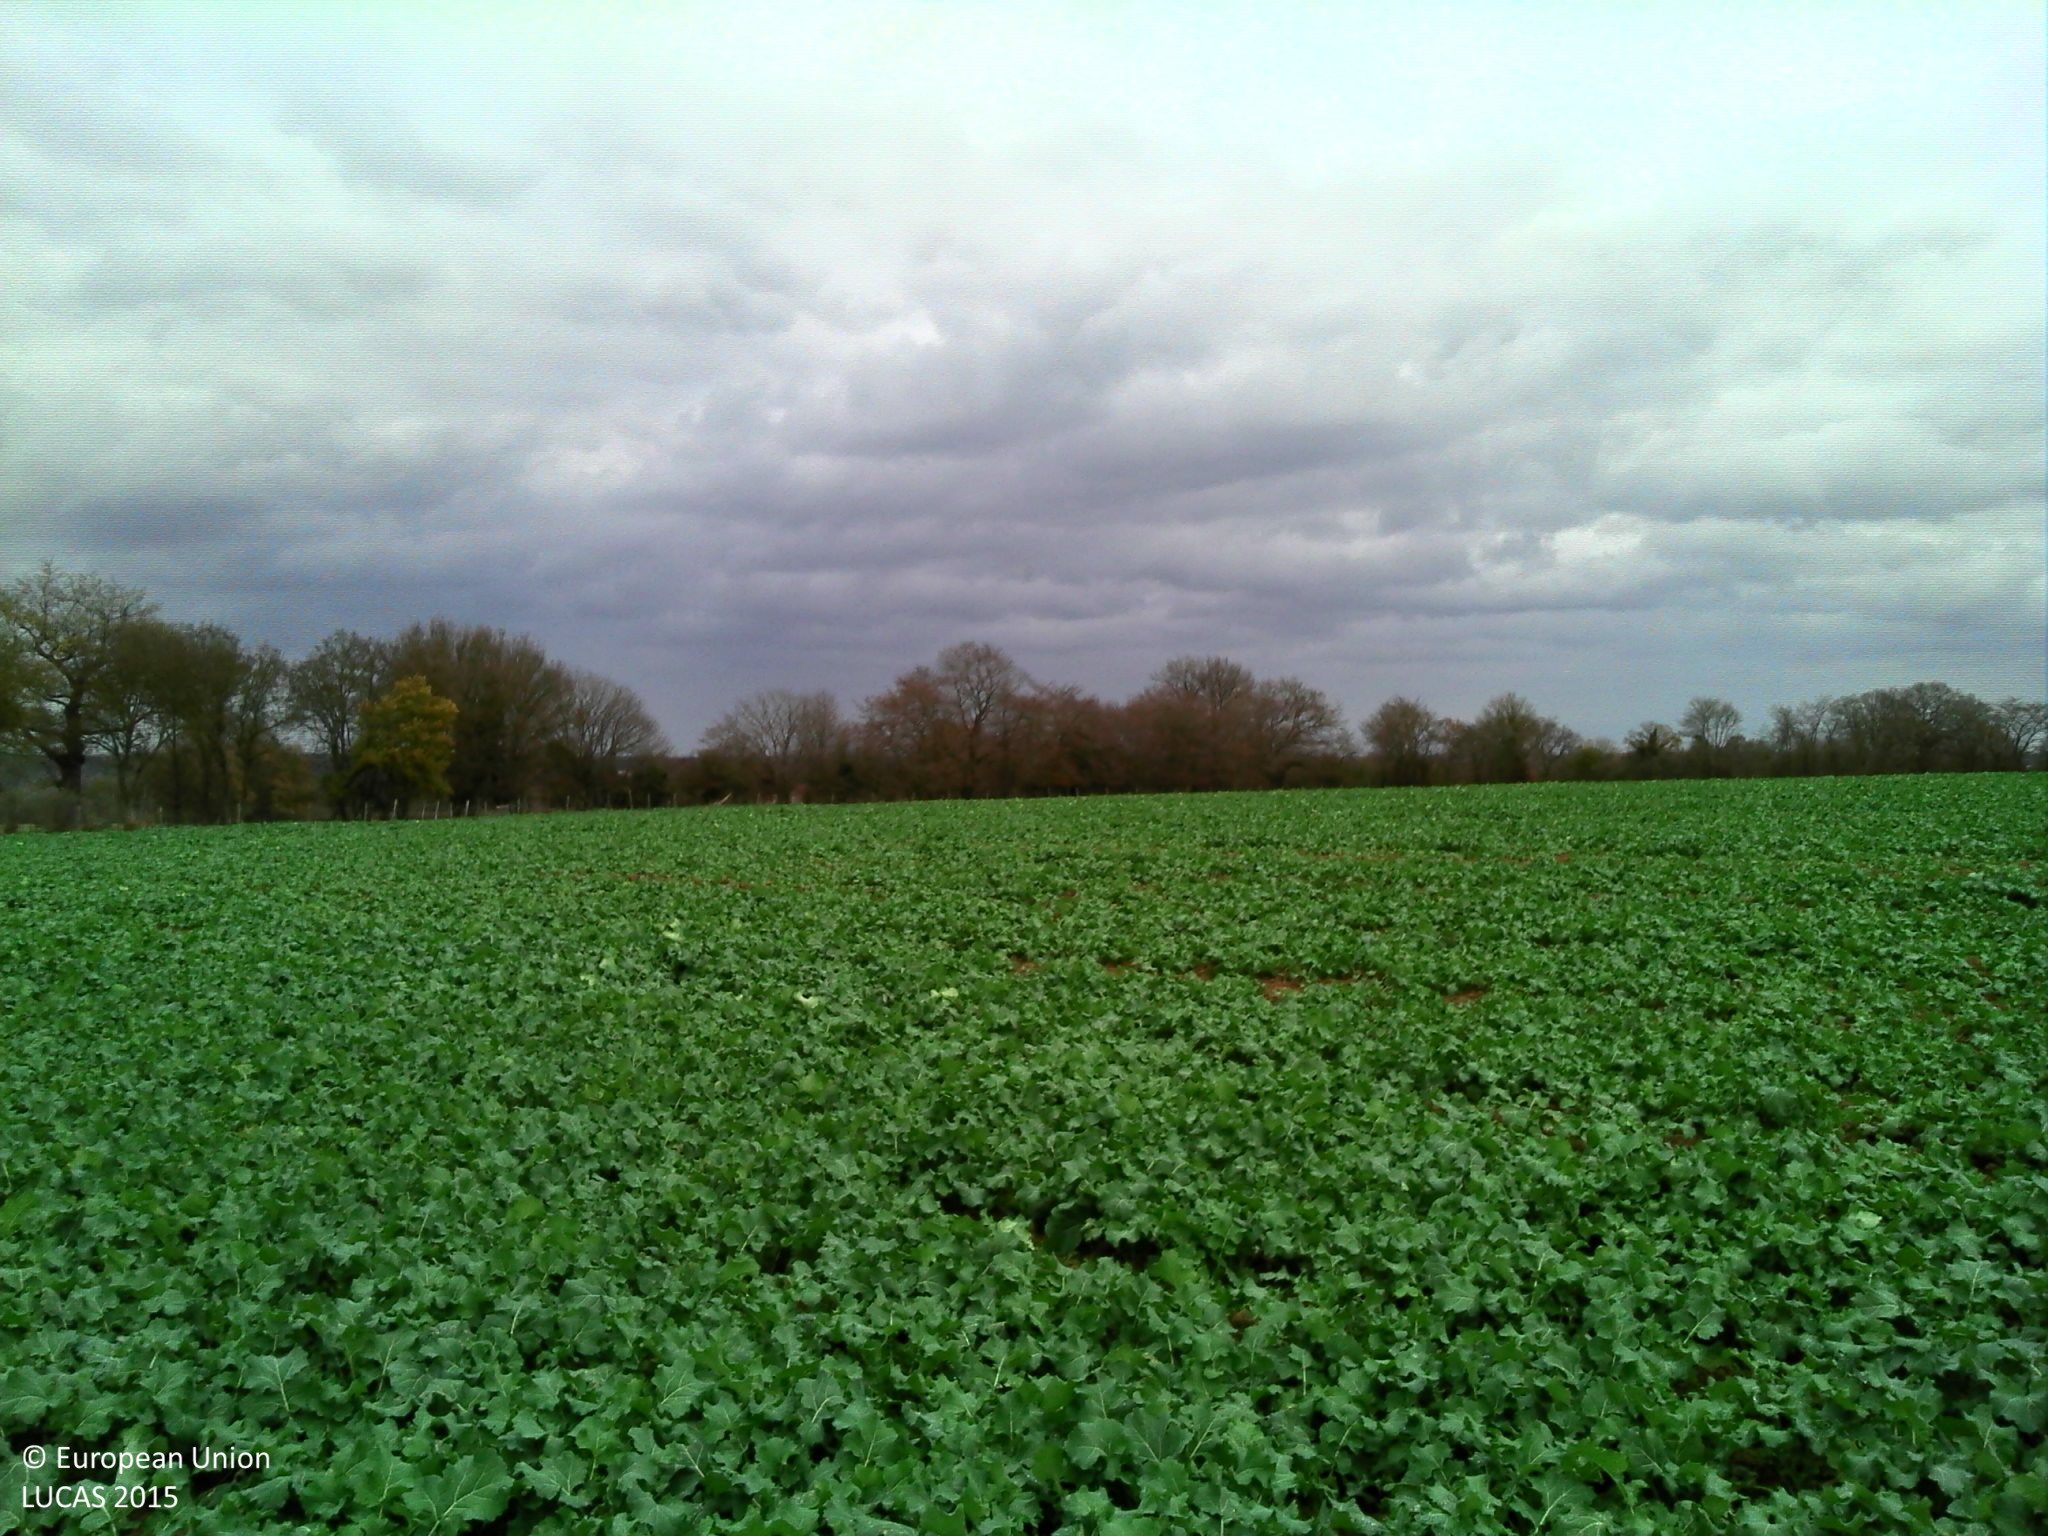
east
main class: Cropland
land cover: Rape and turnip rape
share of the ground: > 75 %
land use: Agriculture (excluding fallow land and kitchen gardens)
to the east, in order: Rape and turnip rape; Grass margins; Fences; Grassland without tree/shrub cover; Broadleaved woodland; Grassland without tree/shrub cover; Fences; Broadleaved woodland; Fences; Grassland without tree/shrub cover
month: November
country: FR
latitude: 46.6255
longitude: 3.2455
